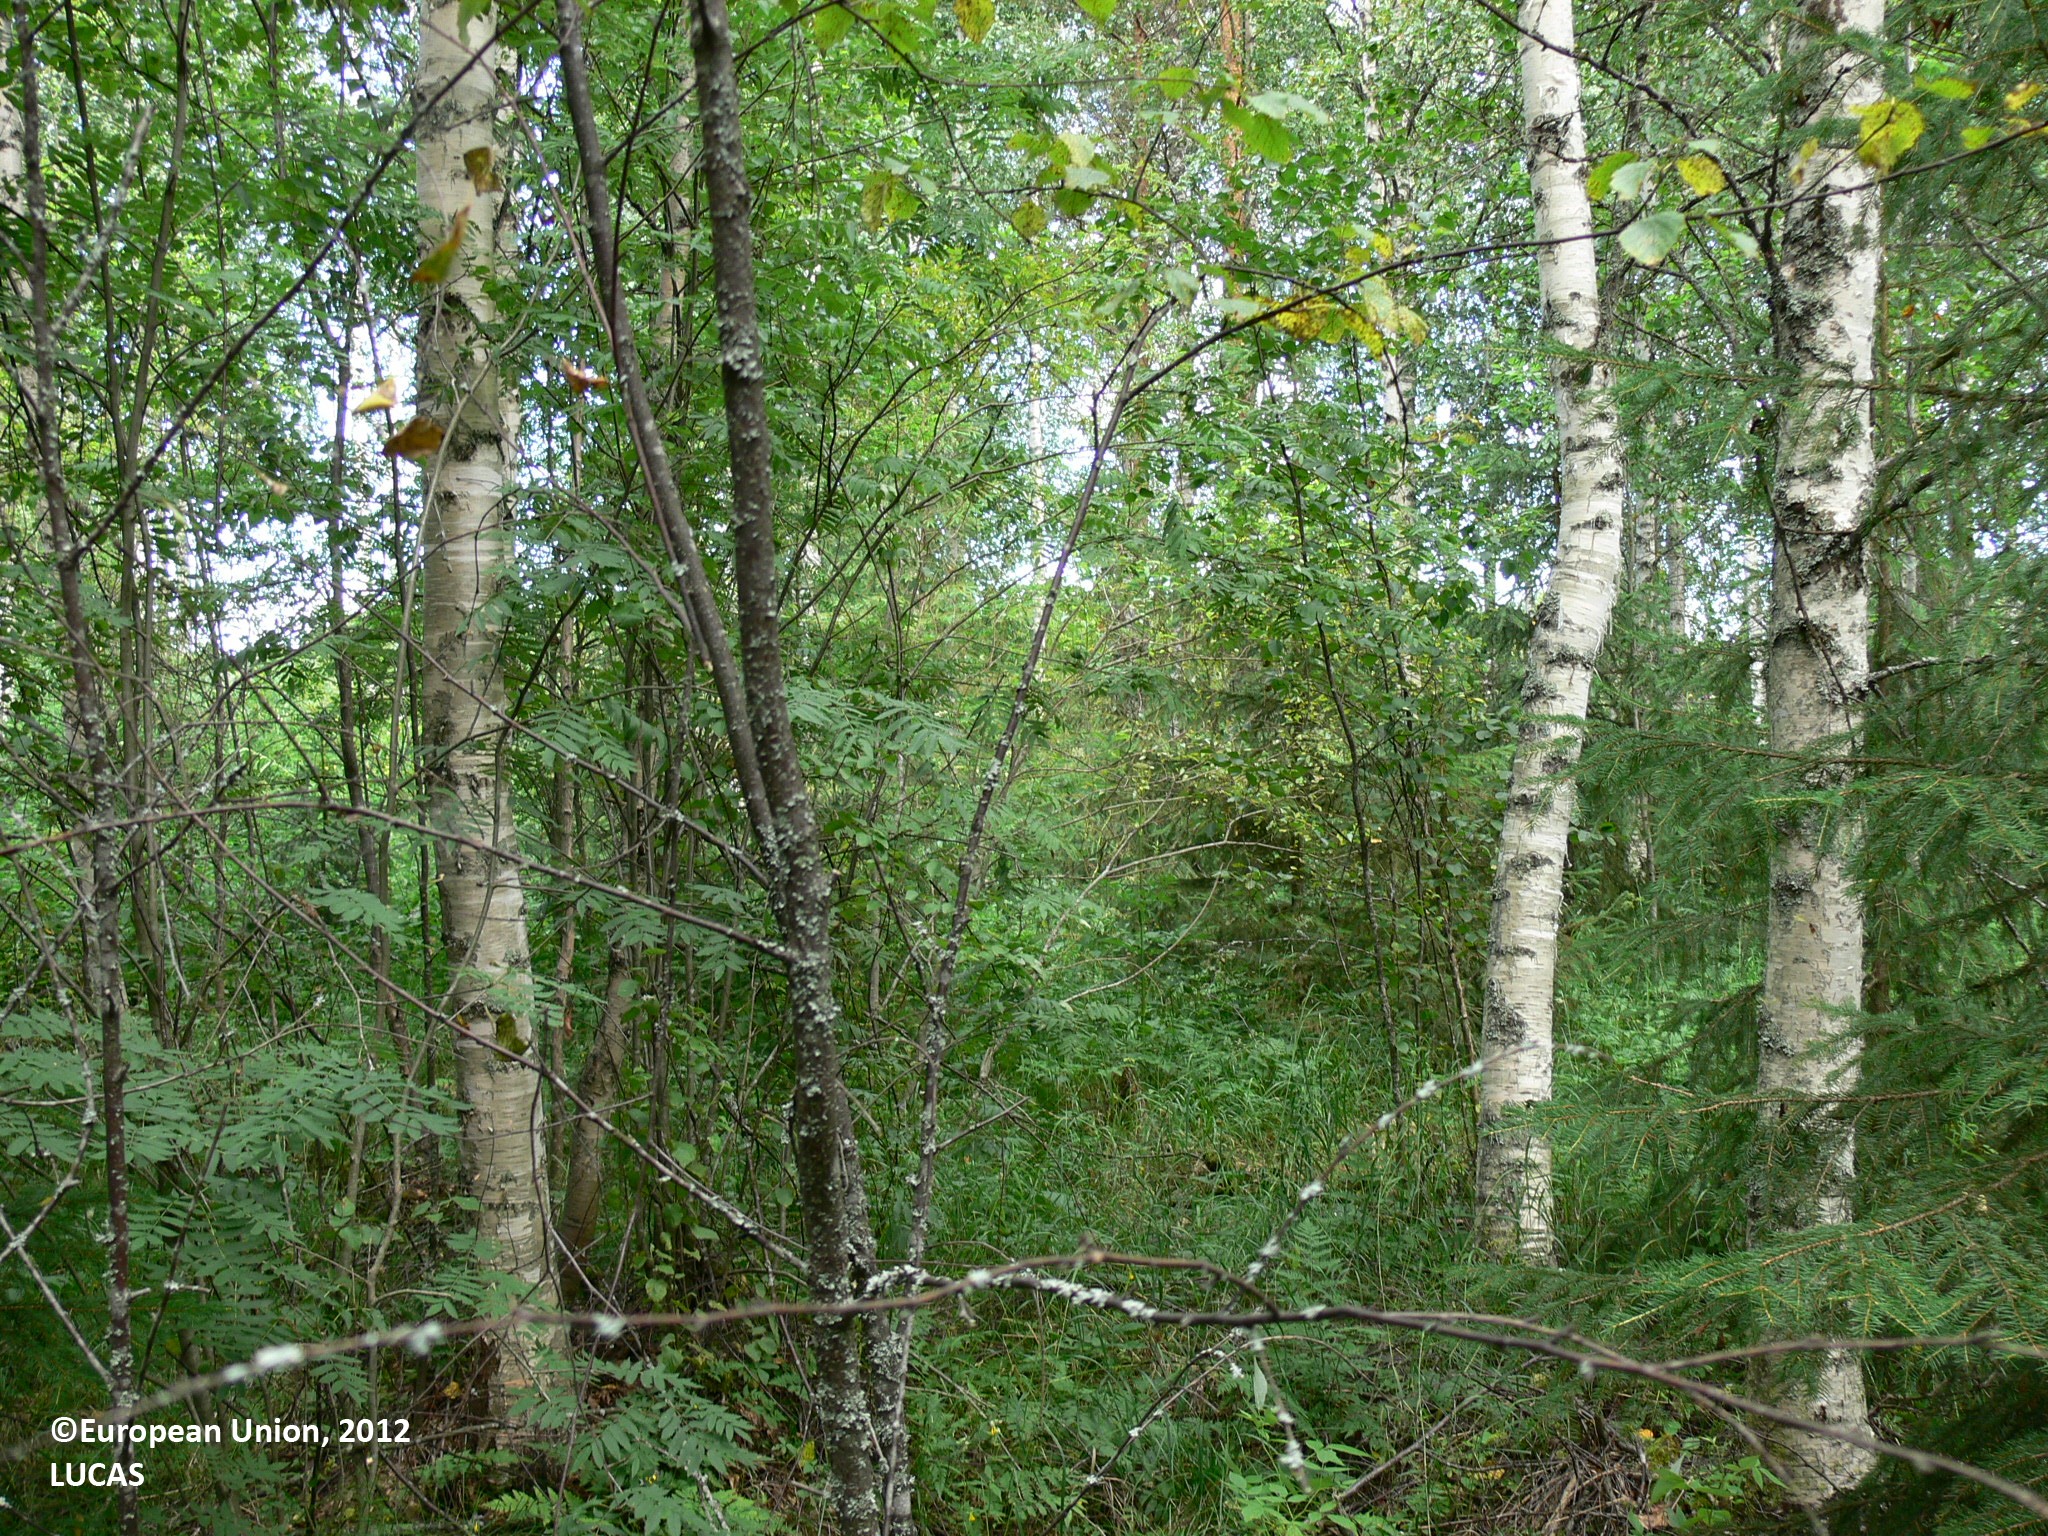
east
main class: Woodland
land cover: Spruce dominated mixed woodland
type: boreal forest
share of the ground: > 75 %
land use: Forestry
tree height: > 5 m
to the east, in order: Spruce dominated mixed woodland; Ditches and canals; Broadleaved woodland; Other coniferous woodland; Ditches and canals; Rape and turnip rape; Ditches and canals; Rape and turnip rape; Ditches and canals; Rape and turnip rape; Ditches and canals; Rape and turnip rape; Ditches and canals; Rape and turnip rape; Ditches and canals; Rape and turnip rape
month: July
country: FI
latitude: 62.0260
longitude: 30.0469
